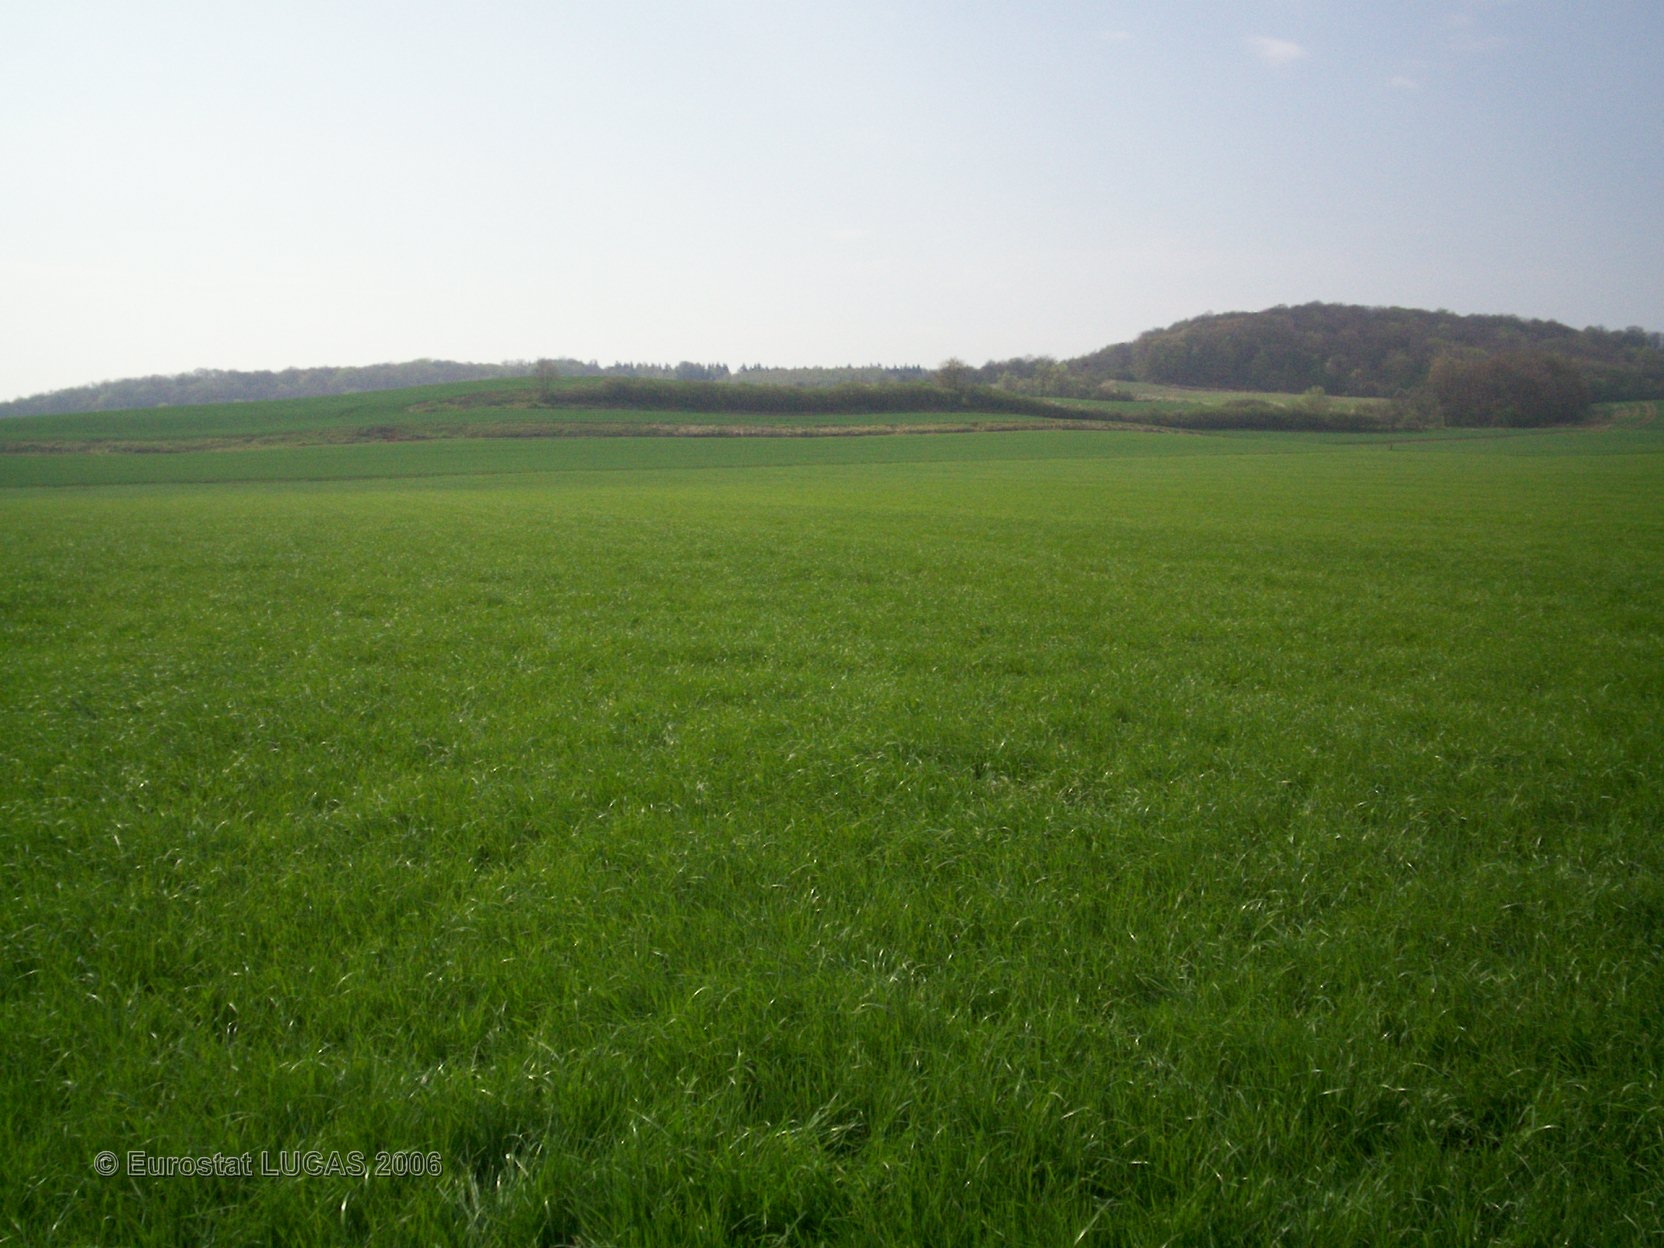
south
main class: Grassland
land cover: Grassland without tree/shrub cover
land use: Agriculture (excluding fallow land and kitchen gardens)
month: April
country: FR
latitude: 48.7633
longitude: 6.5312
